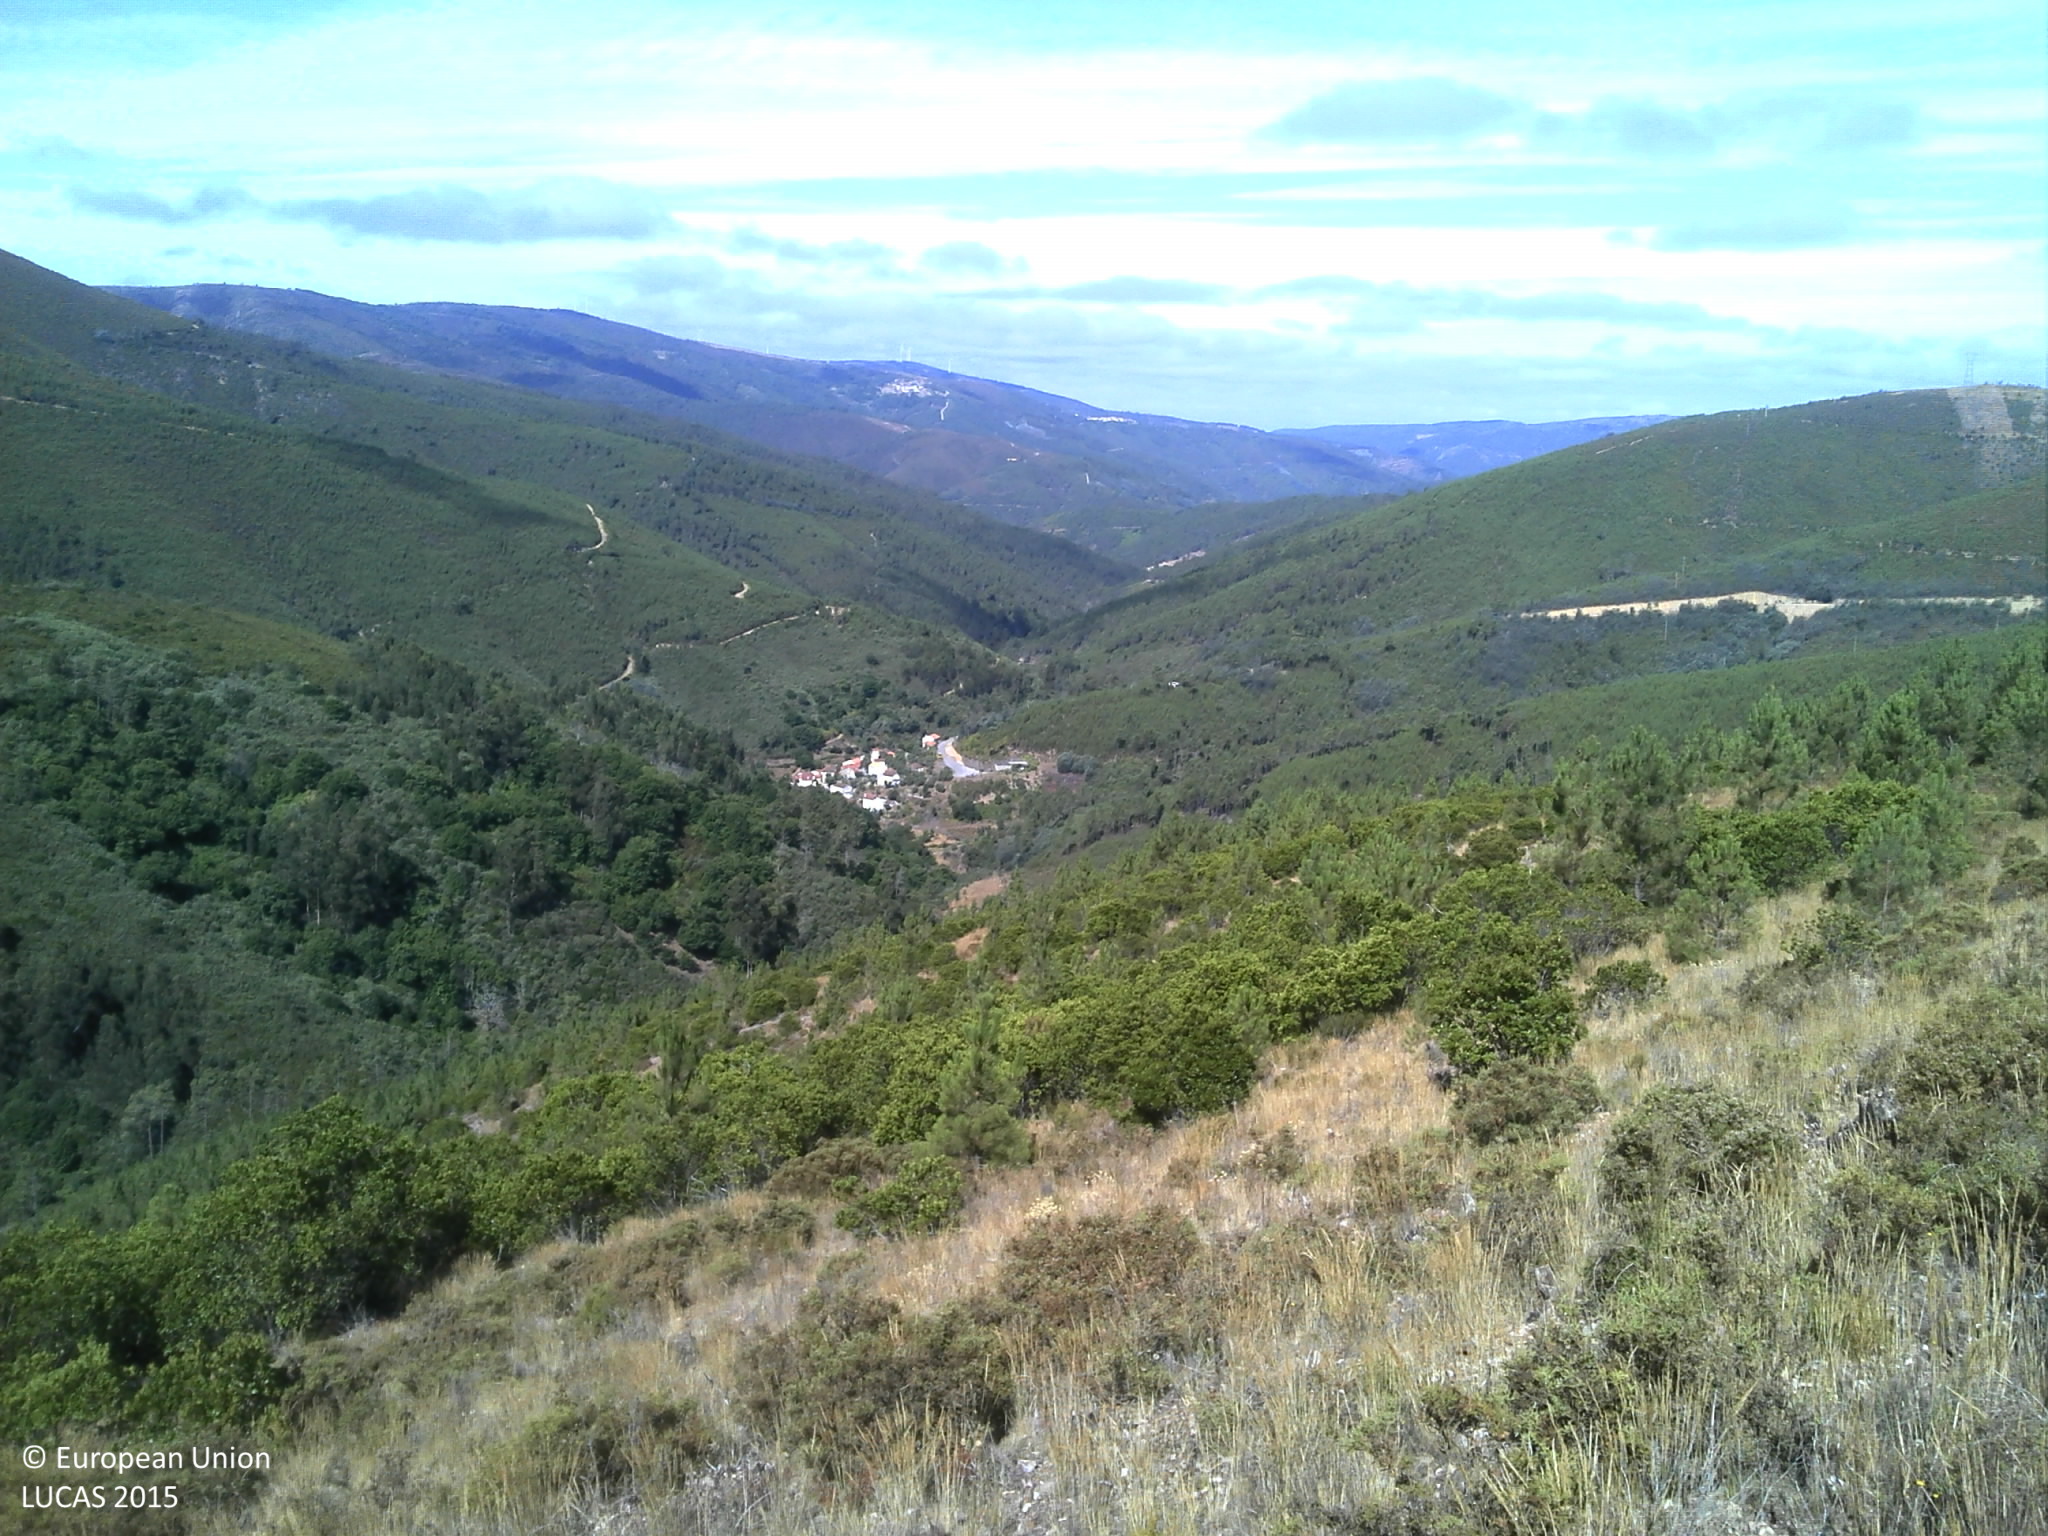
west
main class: Shrubland
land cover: Shrubland without tree cover
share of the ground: > 75 %
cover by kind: shrubs 75 %, unconsolidated bare surface 25 %
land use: Semi-natural and natural areas not in use
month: July
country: PT
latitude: 40.1357
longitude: -7.9197
